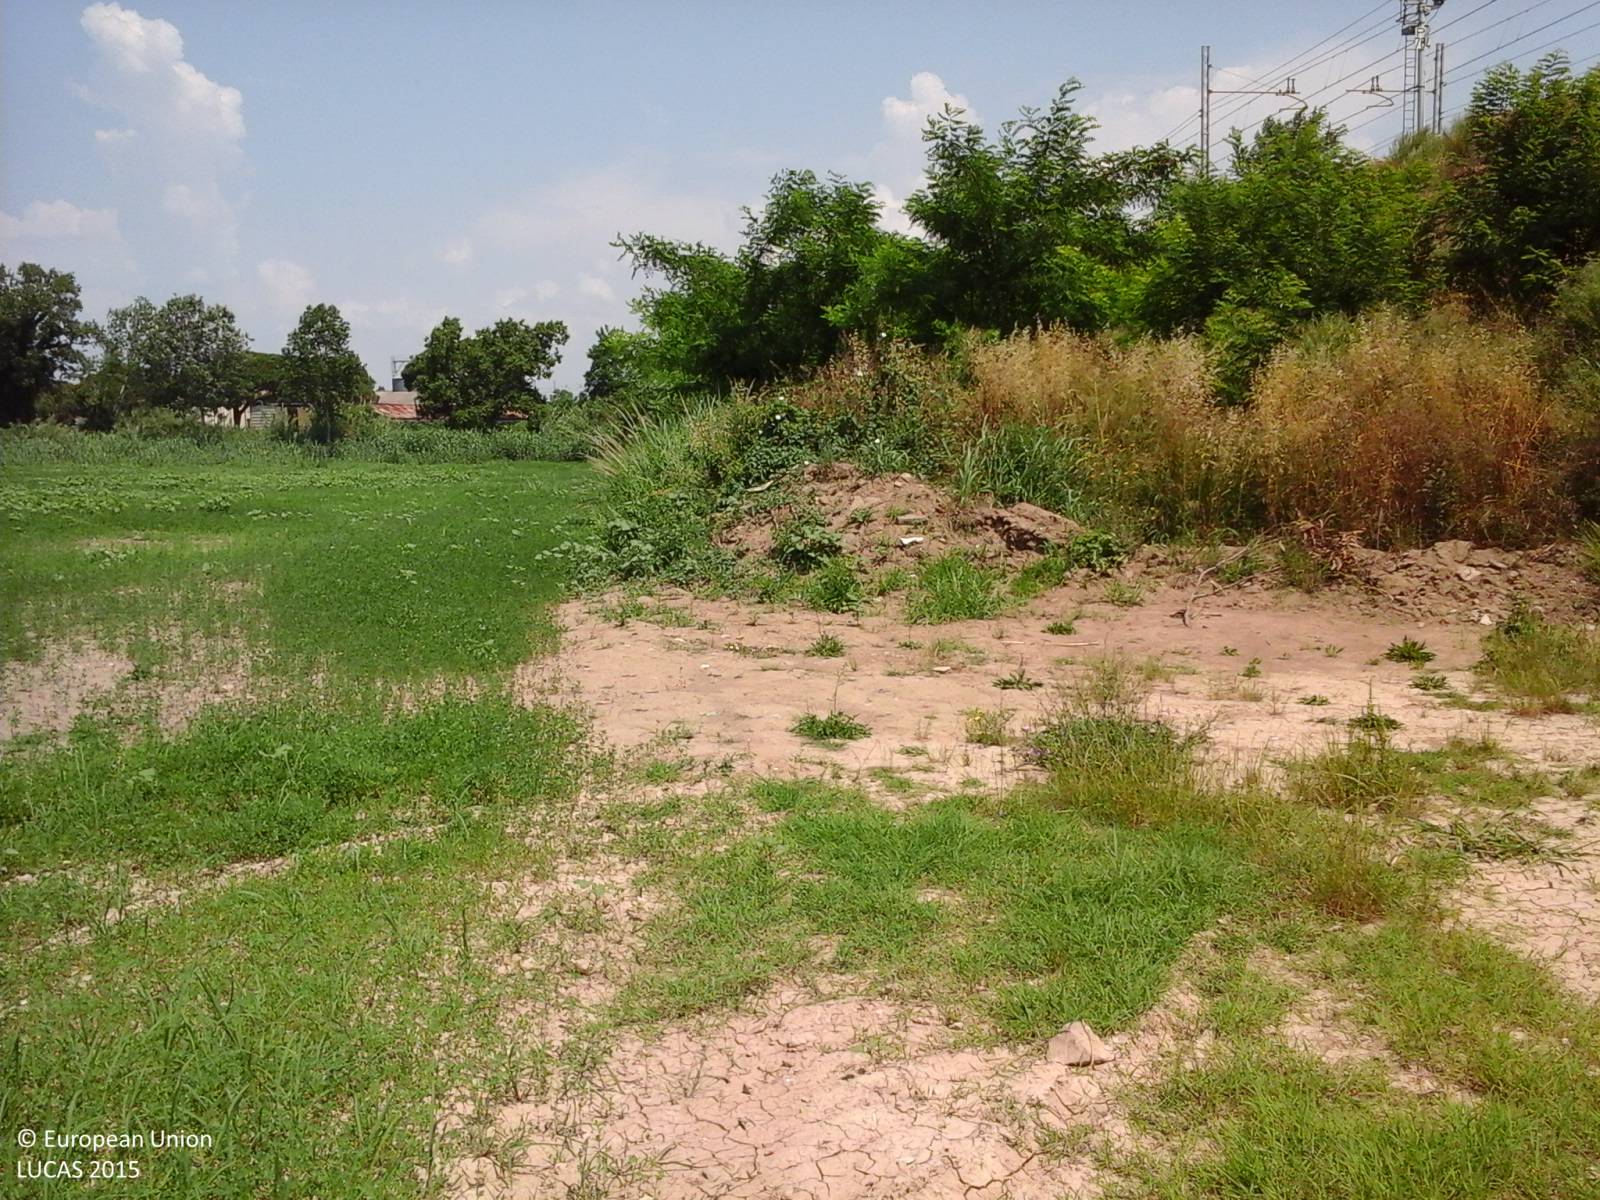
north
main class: Cropland
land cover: Lucerne
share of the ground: 50 - 75 %
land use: Agriculture (excluding fallow land and kitchen gardens)
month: June
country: IT
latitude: 42.3526
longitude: 11.5848
